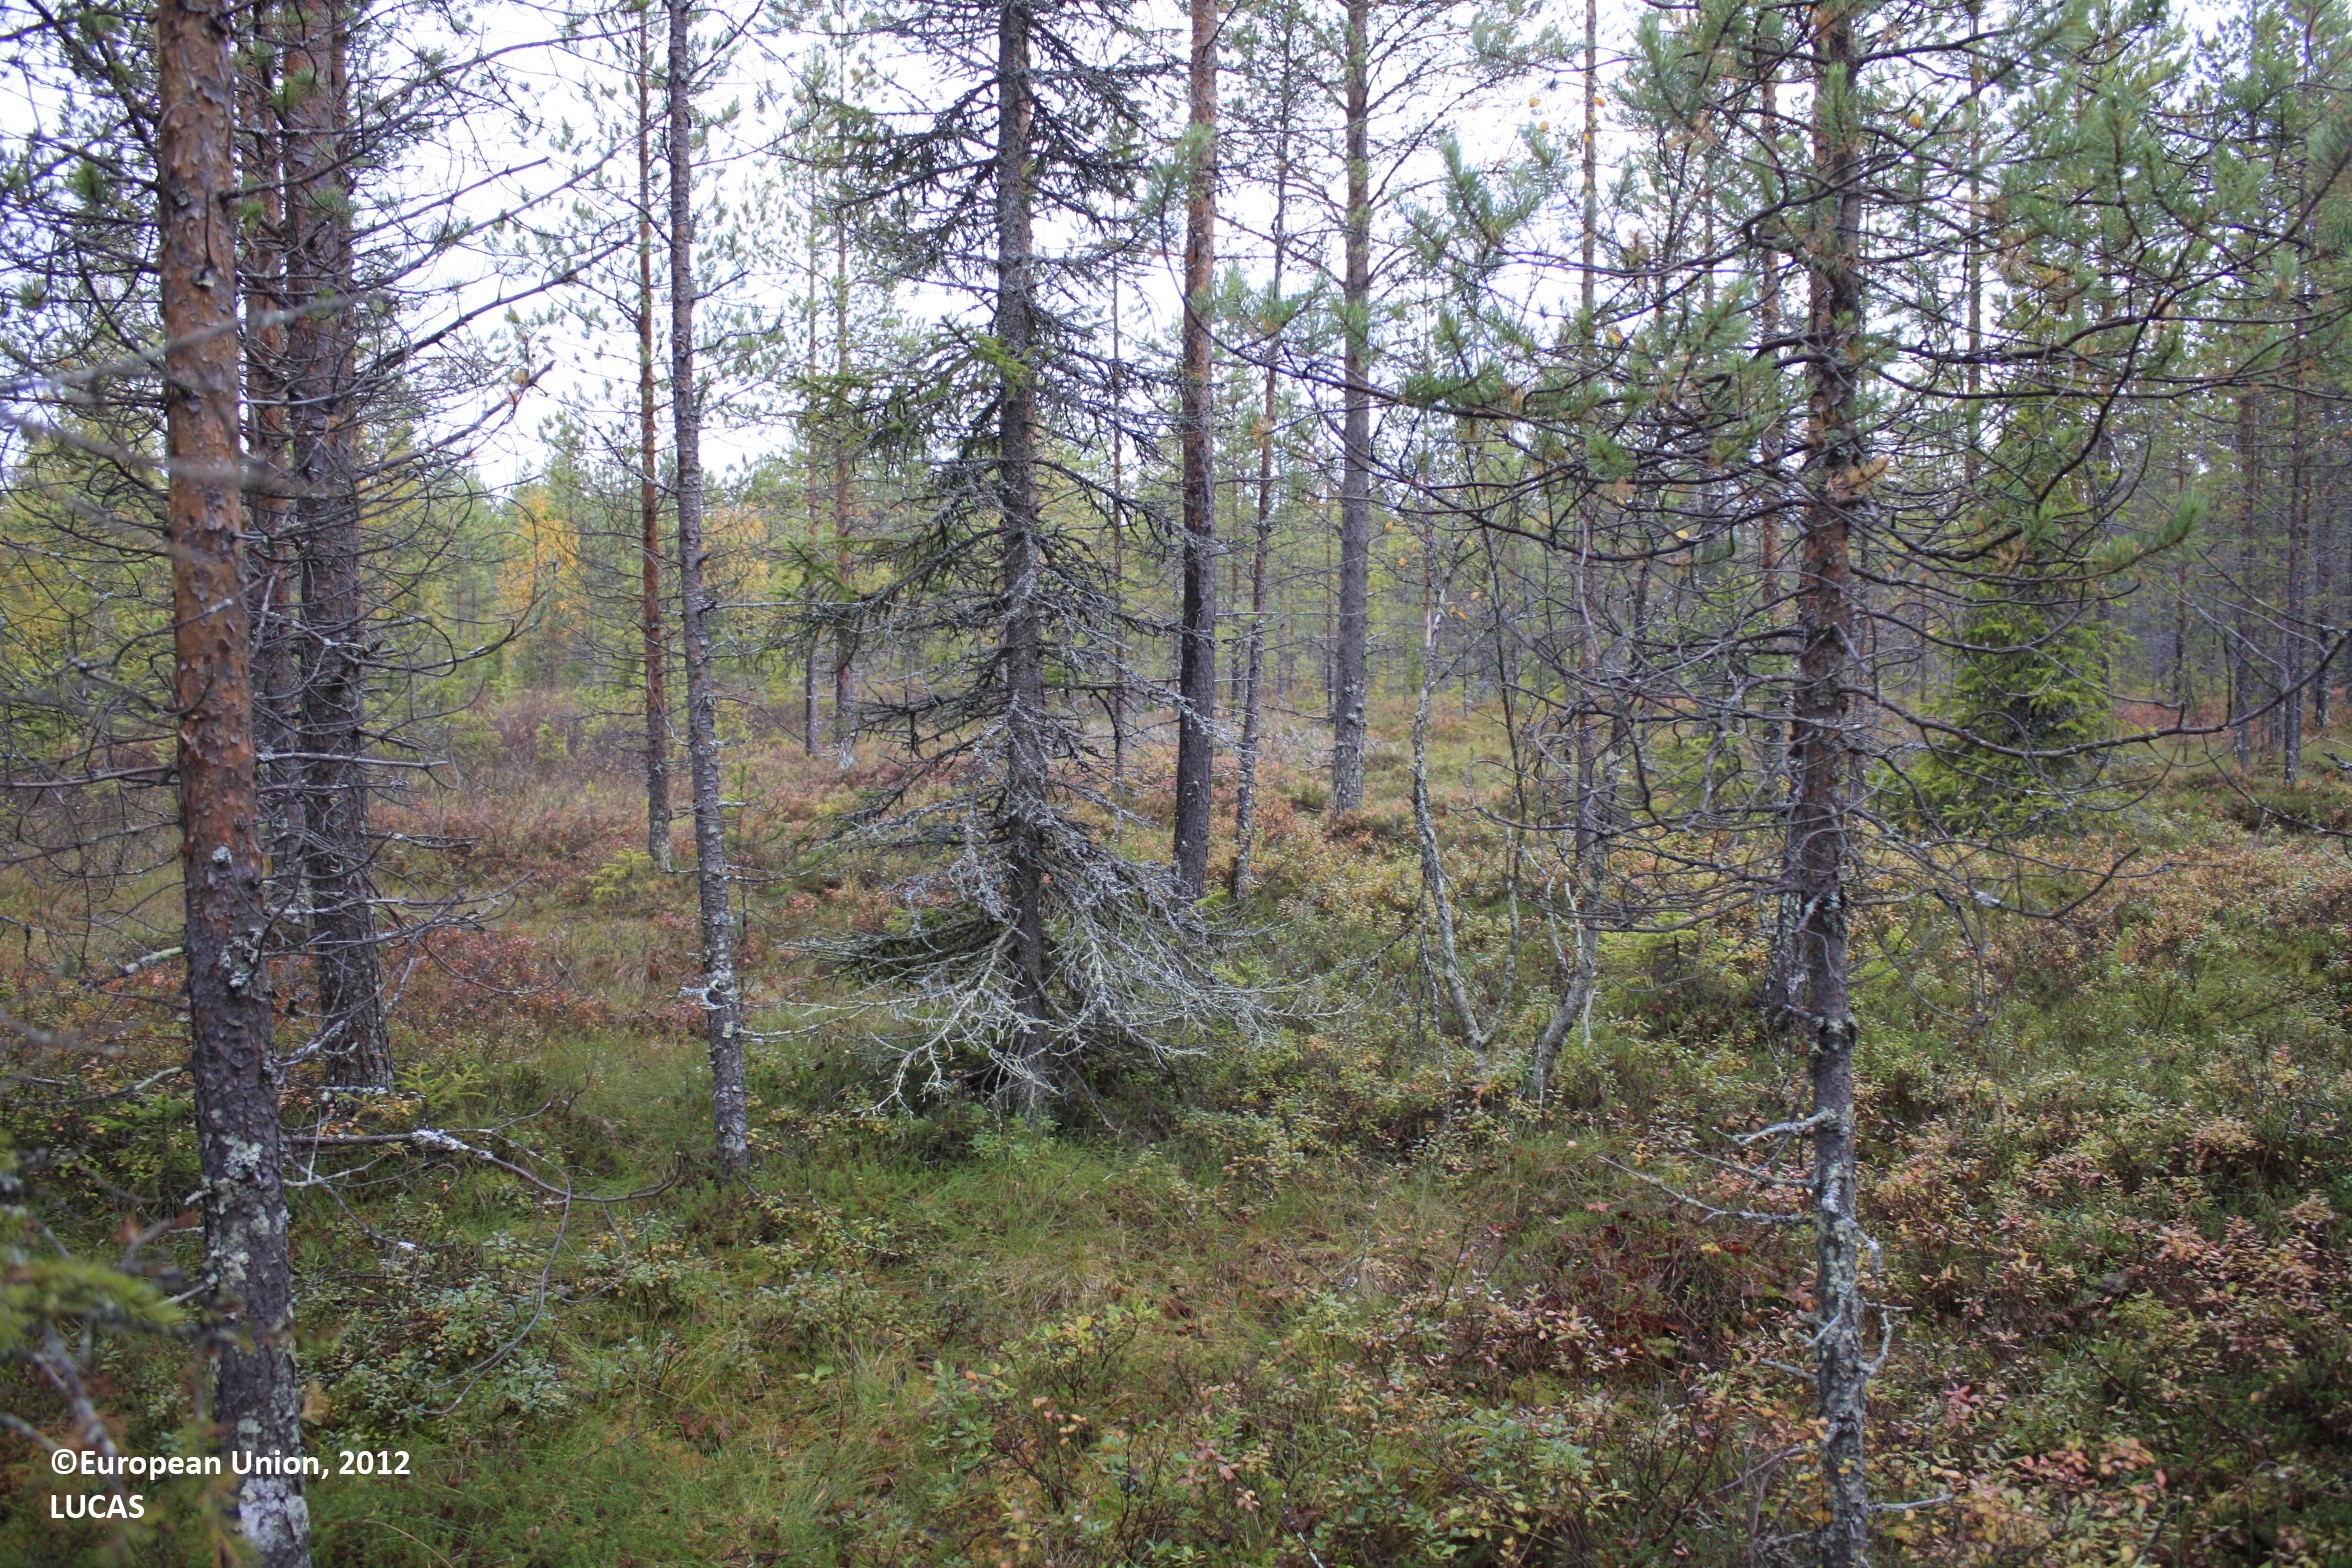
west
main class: Woodland
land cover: Pine dominated coniferous woodland
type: boreal forest
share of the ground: 25 - 50 %
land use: Forestry
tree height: > 5 m
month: September
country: FI
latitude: 65.7325
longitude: 27.2353
